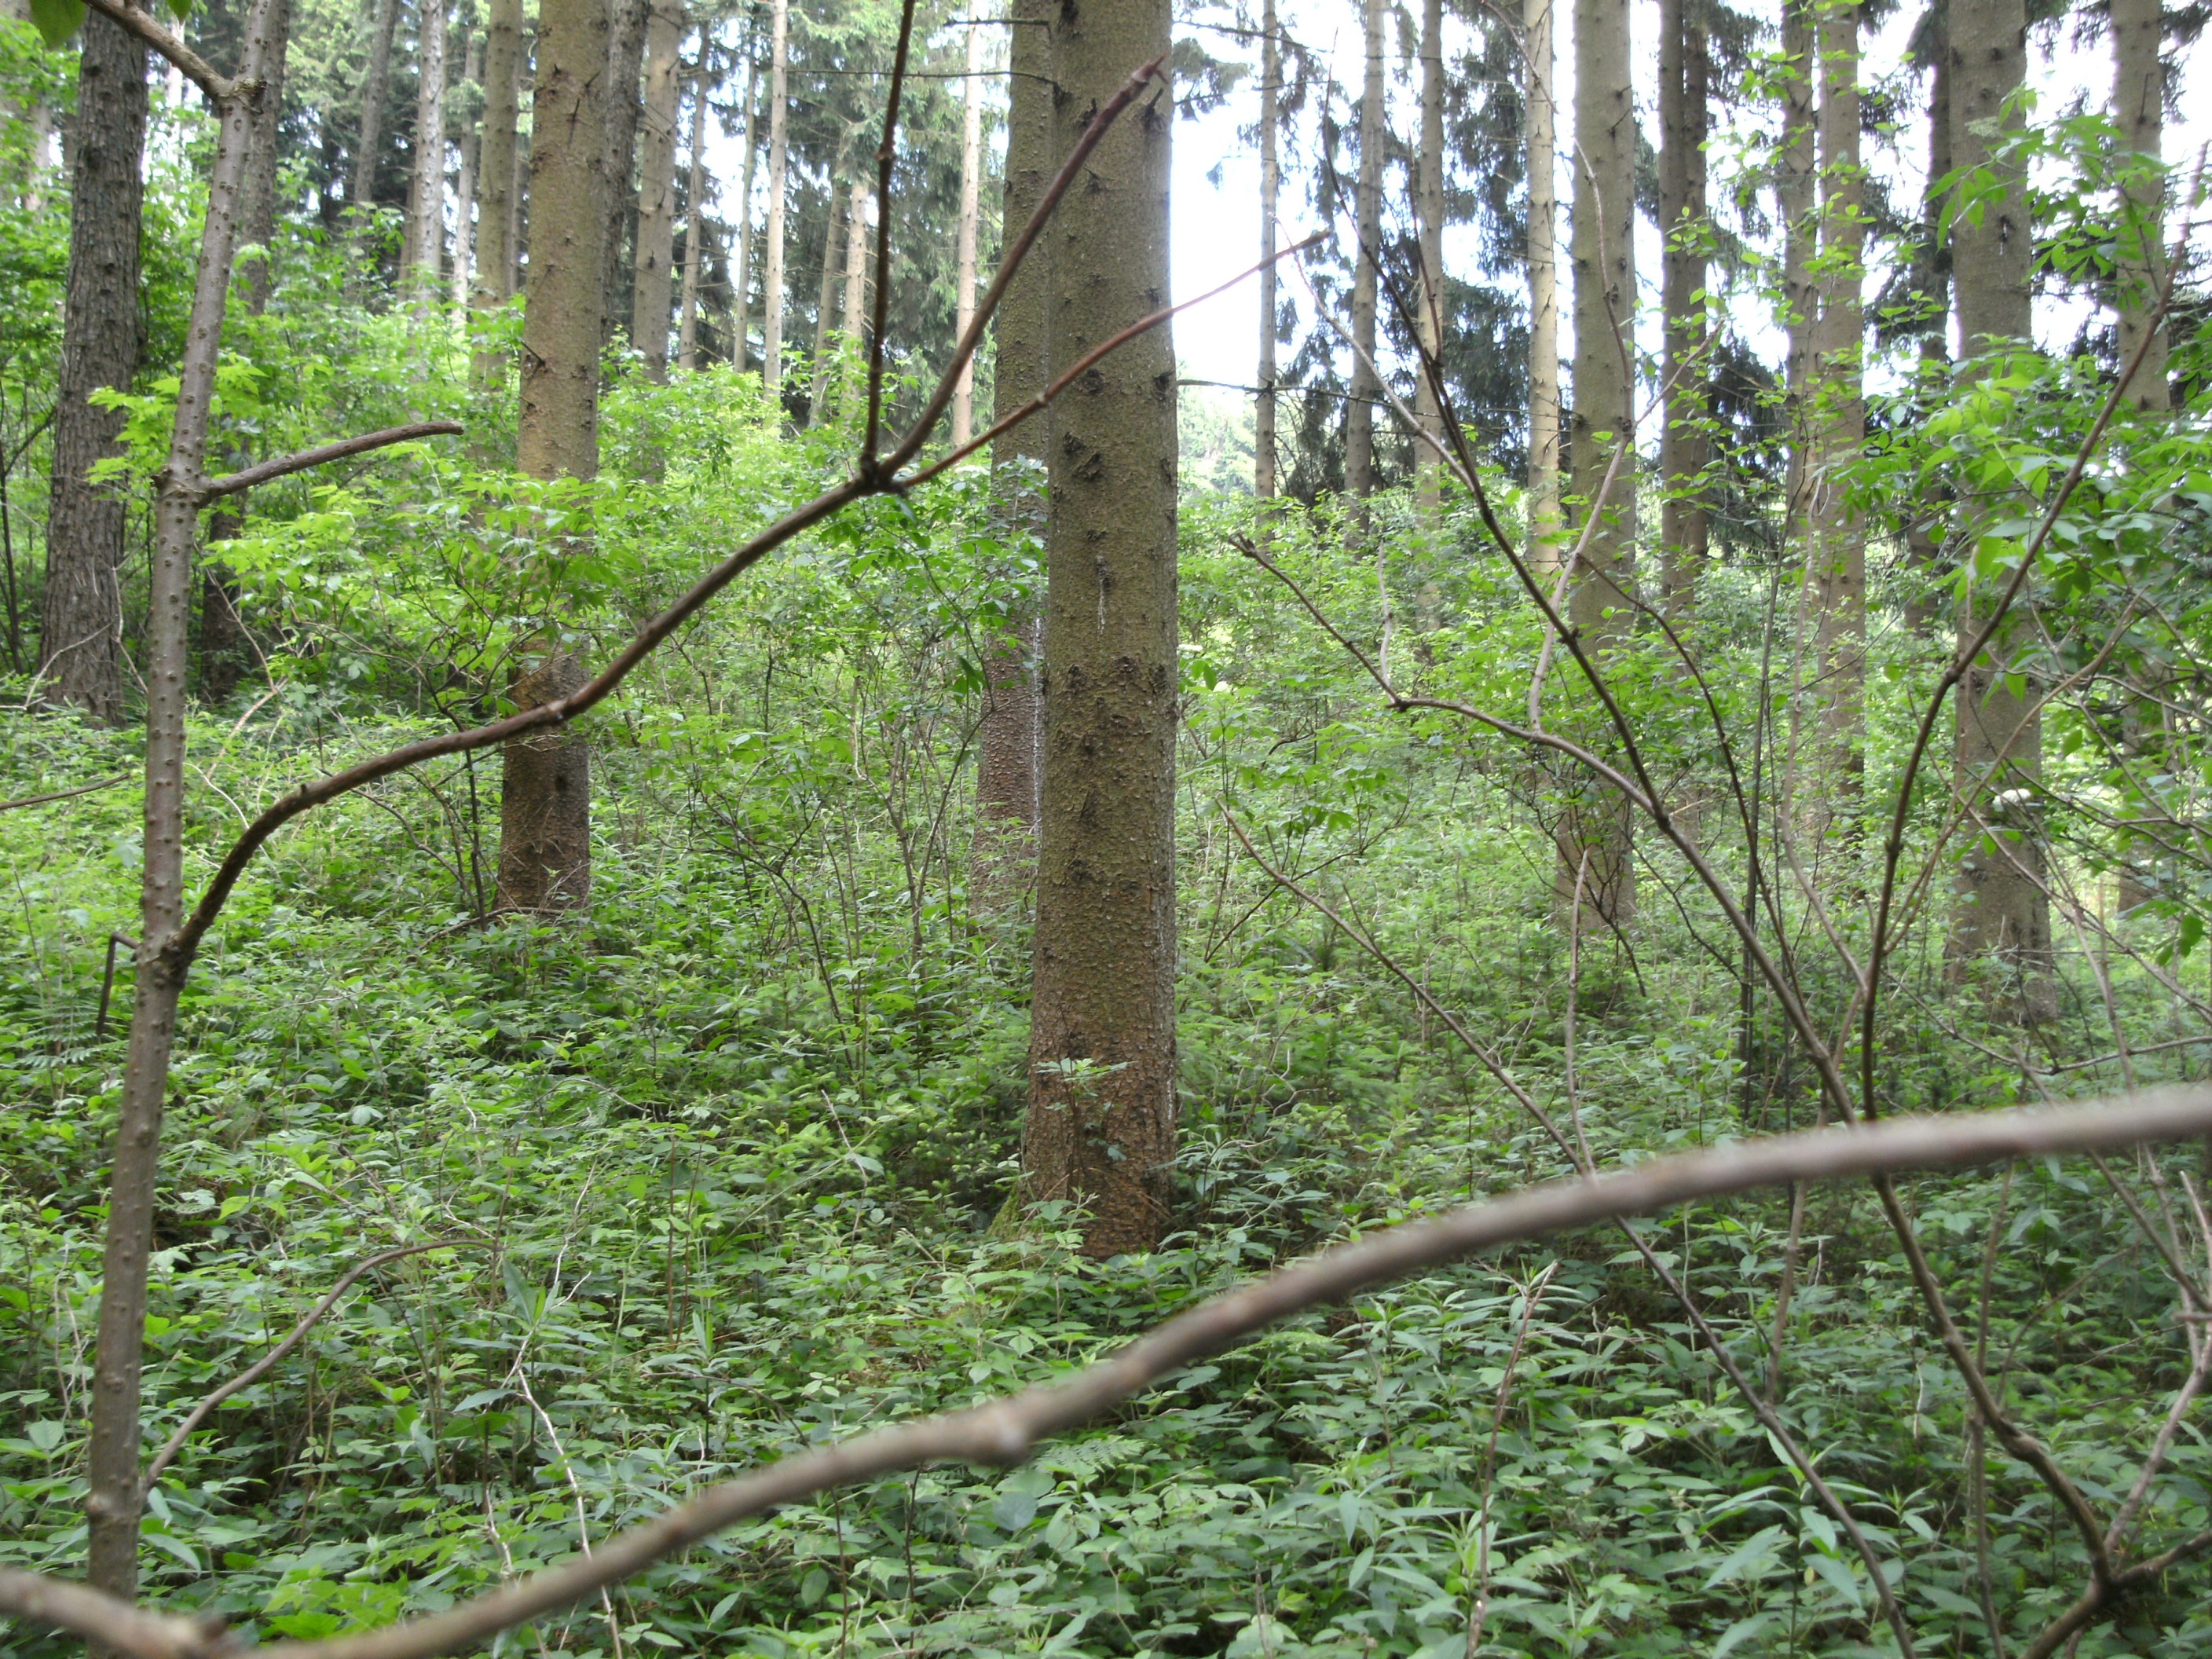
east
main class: Woodland
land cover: Spruce dominated coniferous woodland
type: alpine coniferous forest
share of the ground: > 75 %
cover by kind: coniferous forest trees 80 %, shrubs 15 %, herbaceous plants 5 %
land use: Forestry
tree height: > 5 m
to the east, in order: Spruce dominated coniferous woodland; Tracks; Lines of trees; Dry stone walls; Grassland without tree/shrub cover; Electric lines; Grassland without tree/shrub cover; Fences; Grassland without tree/shrub cover; Fences; Grassland without tree/shrub cover
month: June
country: AT
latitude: 48.5046
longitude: 14.1825
